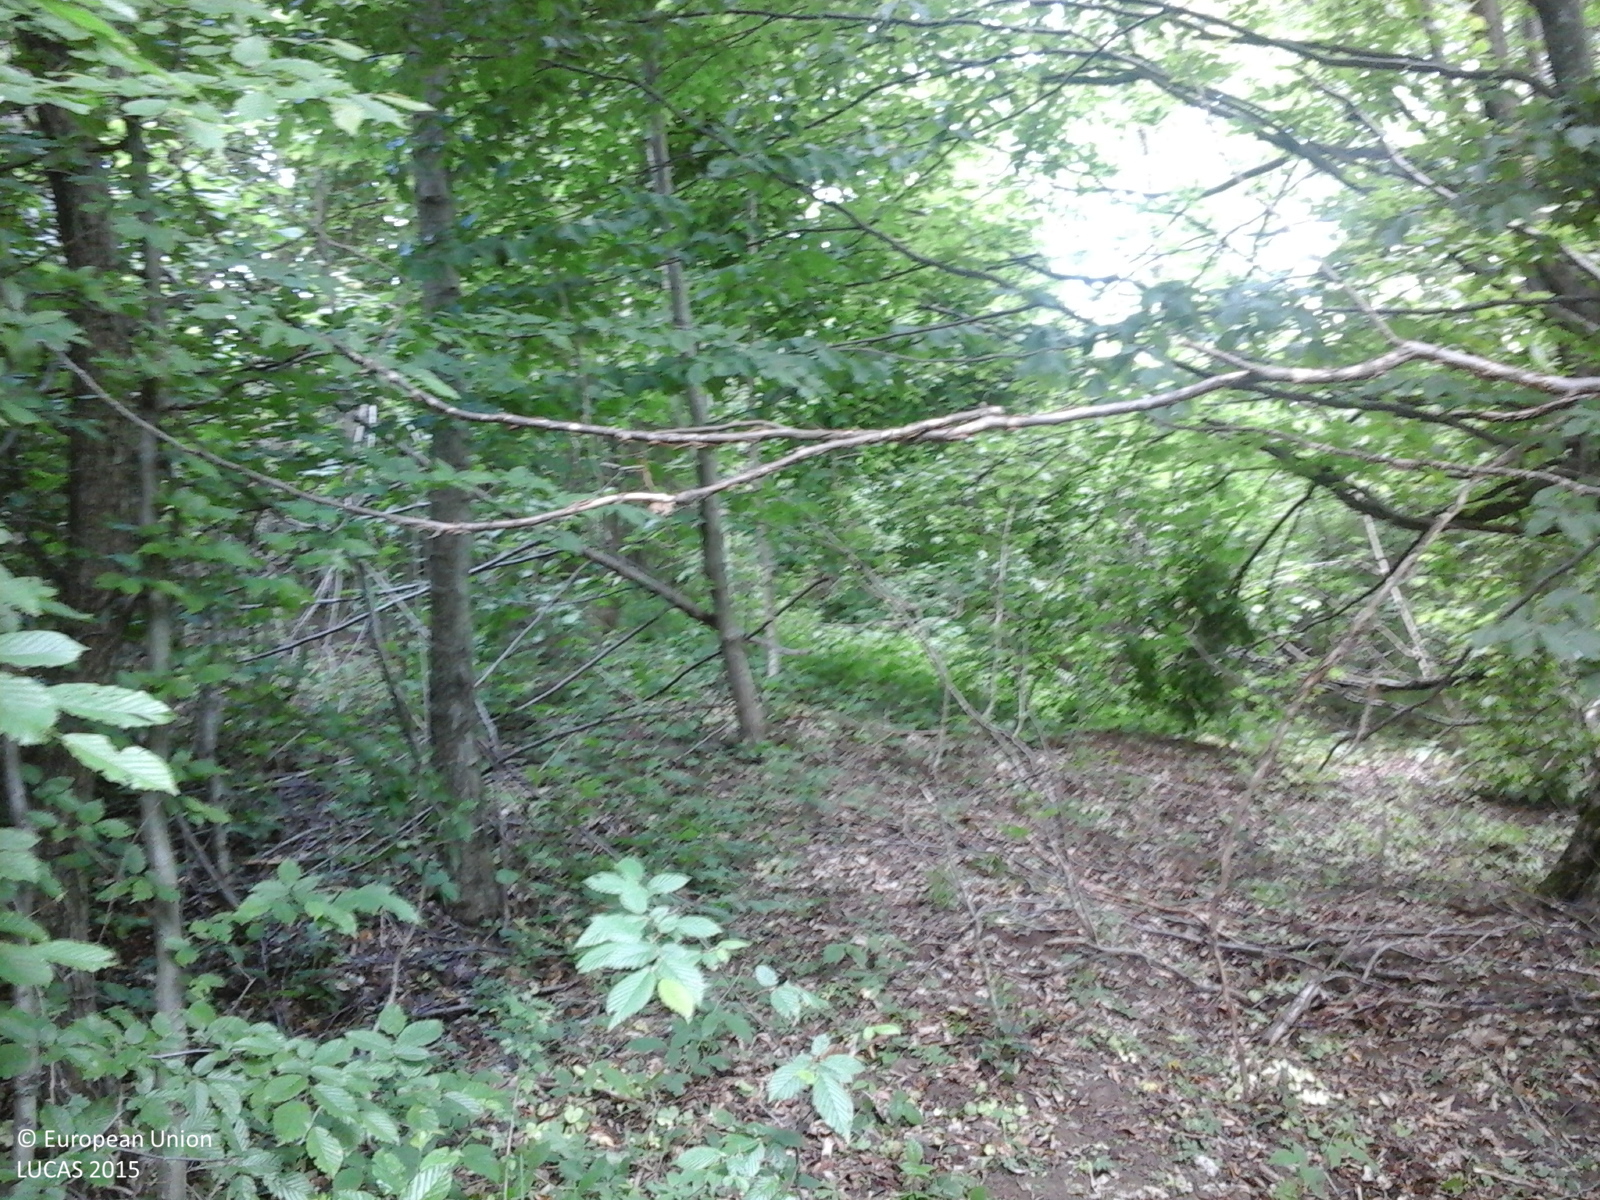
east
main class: Woodland
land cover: Broadleaved woodland
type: beech forest
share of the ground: > 75 %
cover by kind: broadleaved forest trees 100 %
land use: Forestry
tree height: > 5 m
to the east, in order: Broadleaved woodland; Grassland without tree/shrub cover; Tracks; Grassland without tree/shrub cover; Single bushes/trees; Grassland without tree/shrub cover; Grassland with sparse tree/shrub cover; Broadleaved woodland
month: May
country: RO
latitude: 45.7968
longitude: 25.2663
